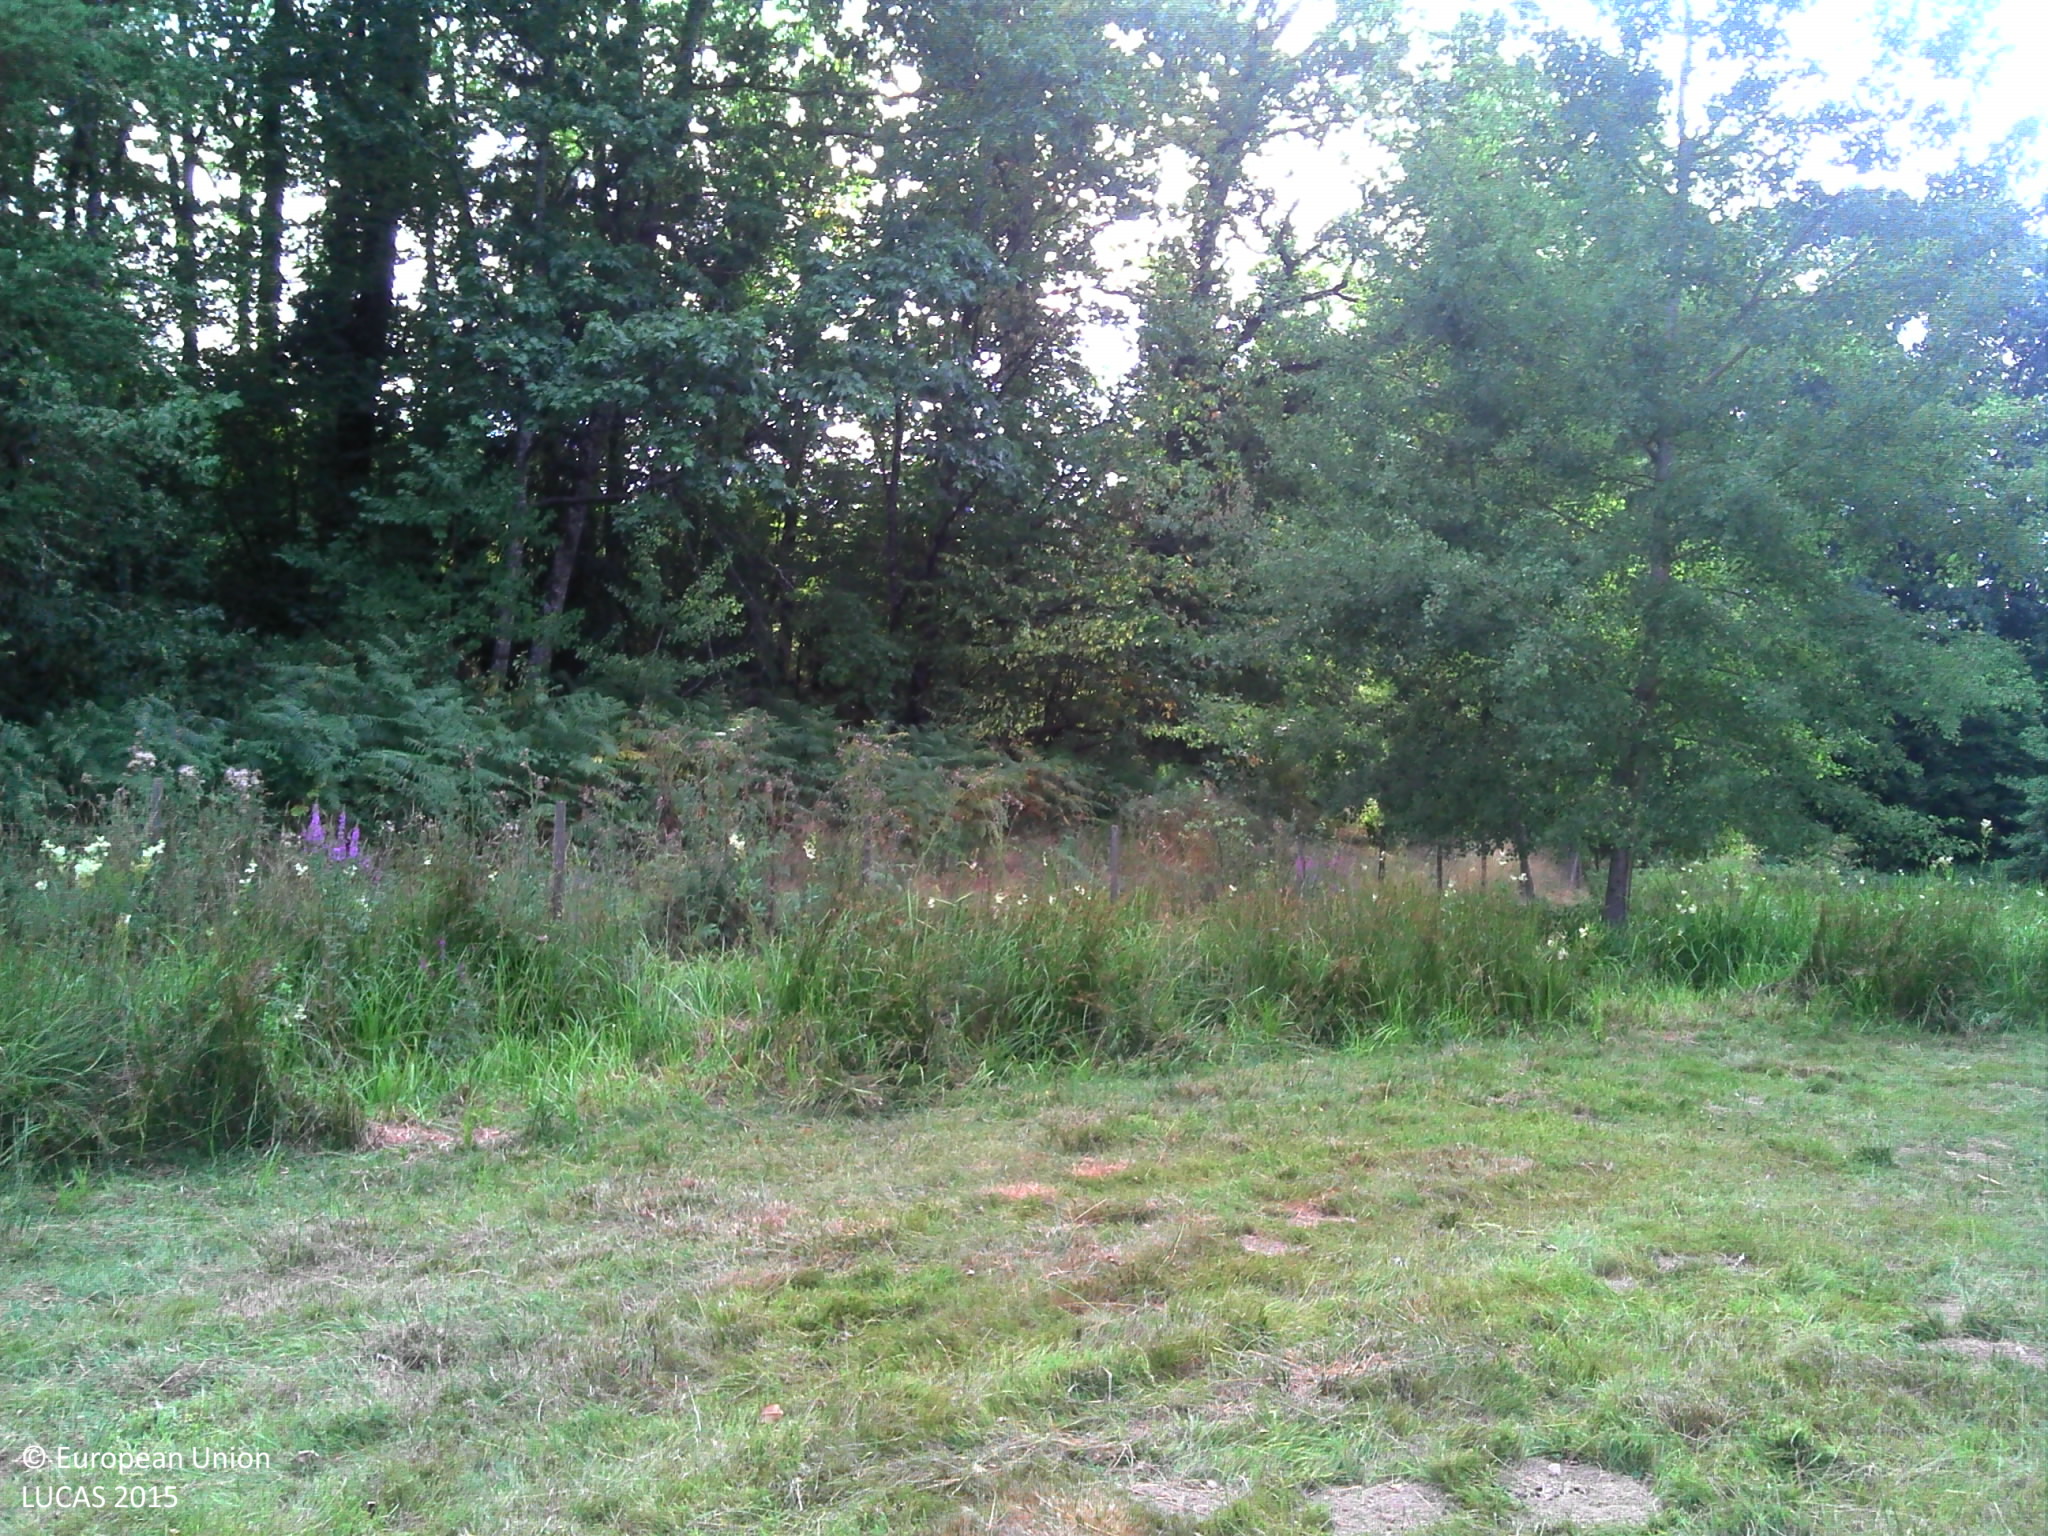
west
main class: Grassland
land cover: Grassland without tree/shrub cover
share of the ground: > 75 %
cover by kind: herbaceous plants 80 %, unconsolidated bare surface 15 %, shrubs 5 %
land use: Agriculture (excluding fallow land and kitchen gardens)
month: July
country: FR
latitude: 45.3821
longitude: 1.3216
